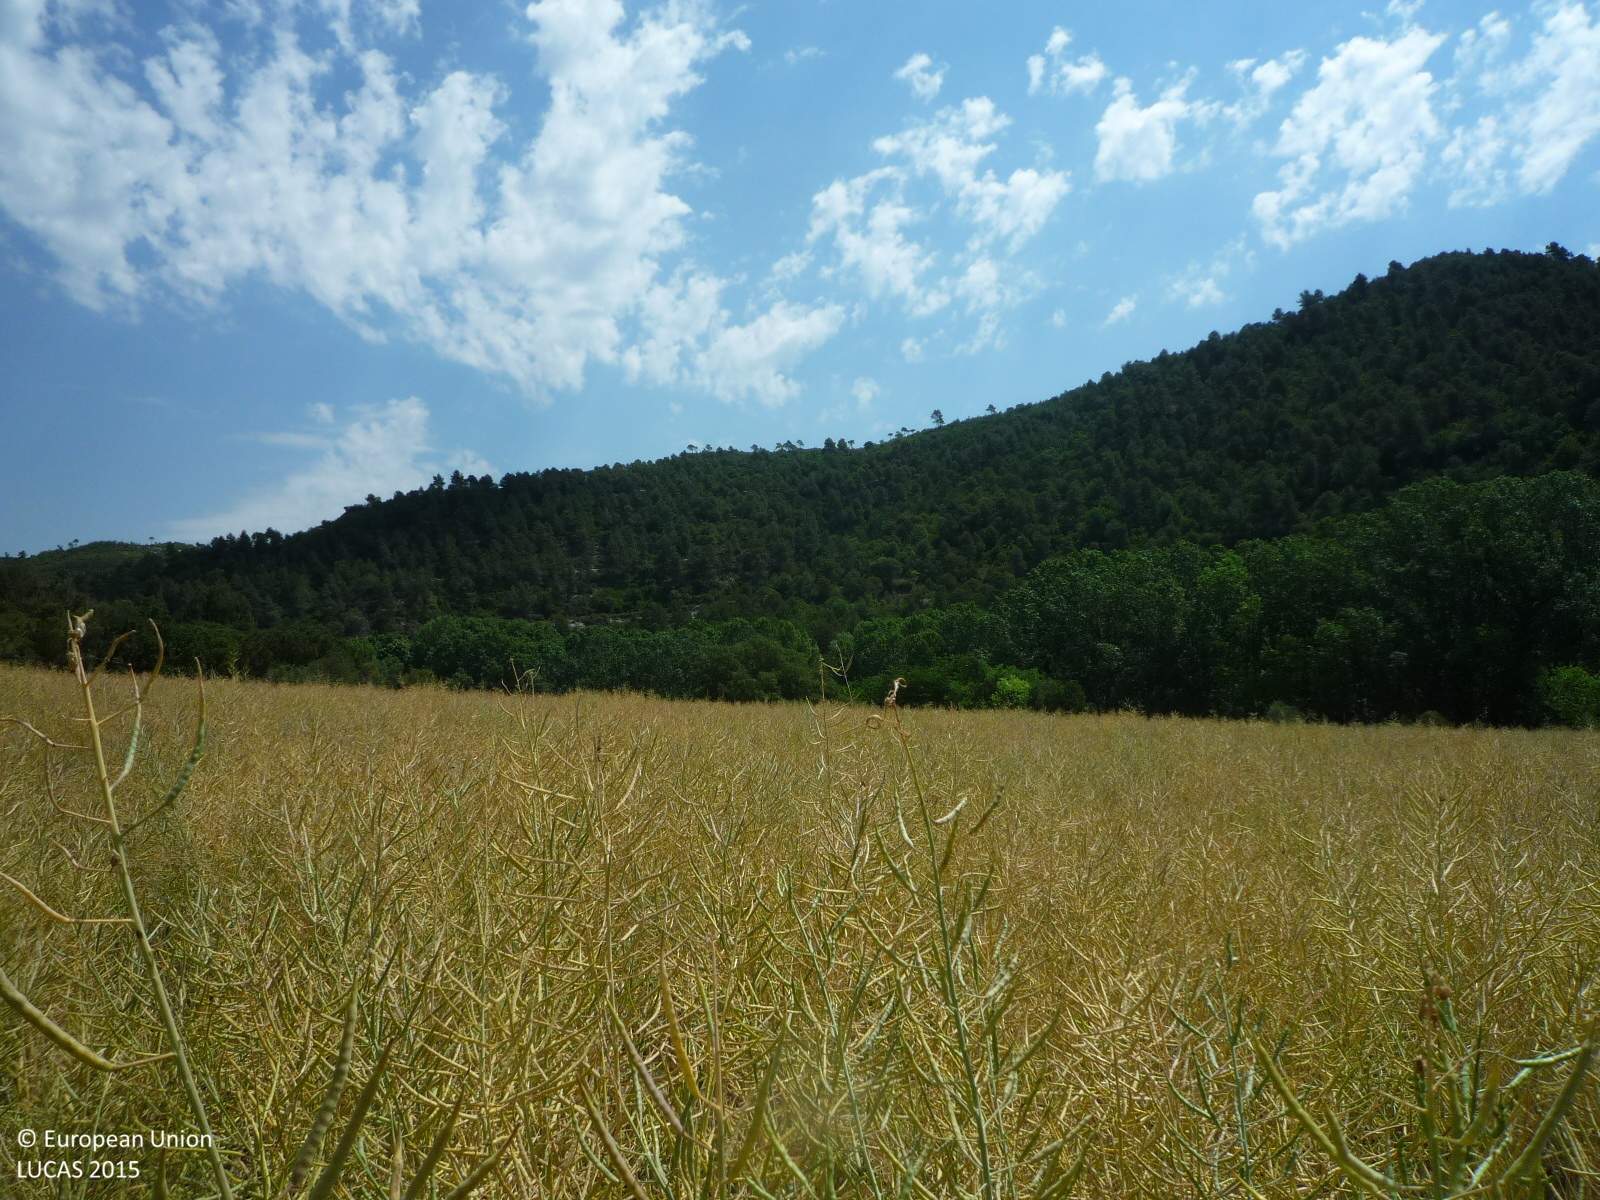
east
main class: Cropland
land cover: Rape and turnip rape
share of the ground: > 75 %
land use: Agriculture (excluding fallow land and kitchen gardens)
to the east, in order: Rape and turnip rape; Grass margins; Tracks; Grass margins; Groves; Rape and turnip rape; Broadleaved woodland; Rivers and streams; Rocks and stones; Pine dominated mixed woodland
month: June
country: ES
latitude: 41.7740
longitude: 1.9911
